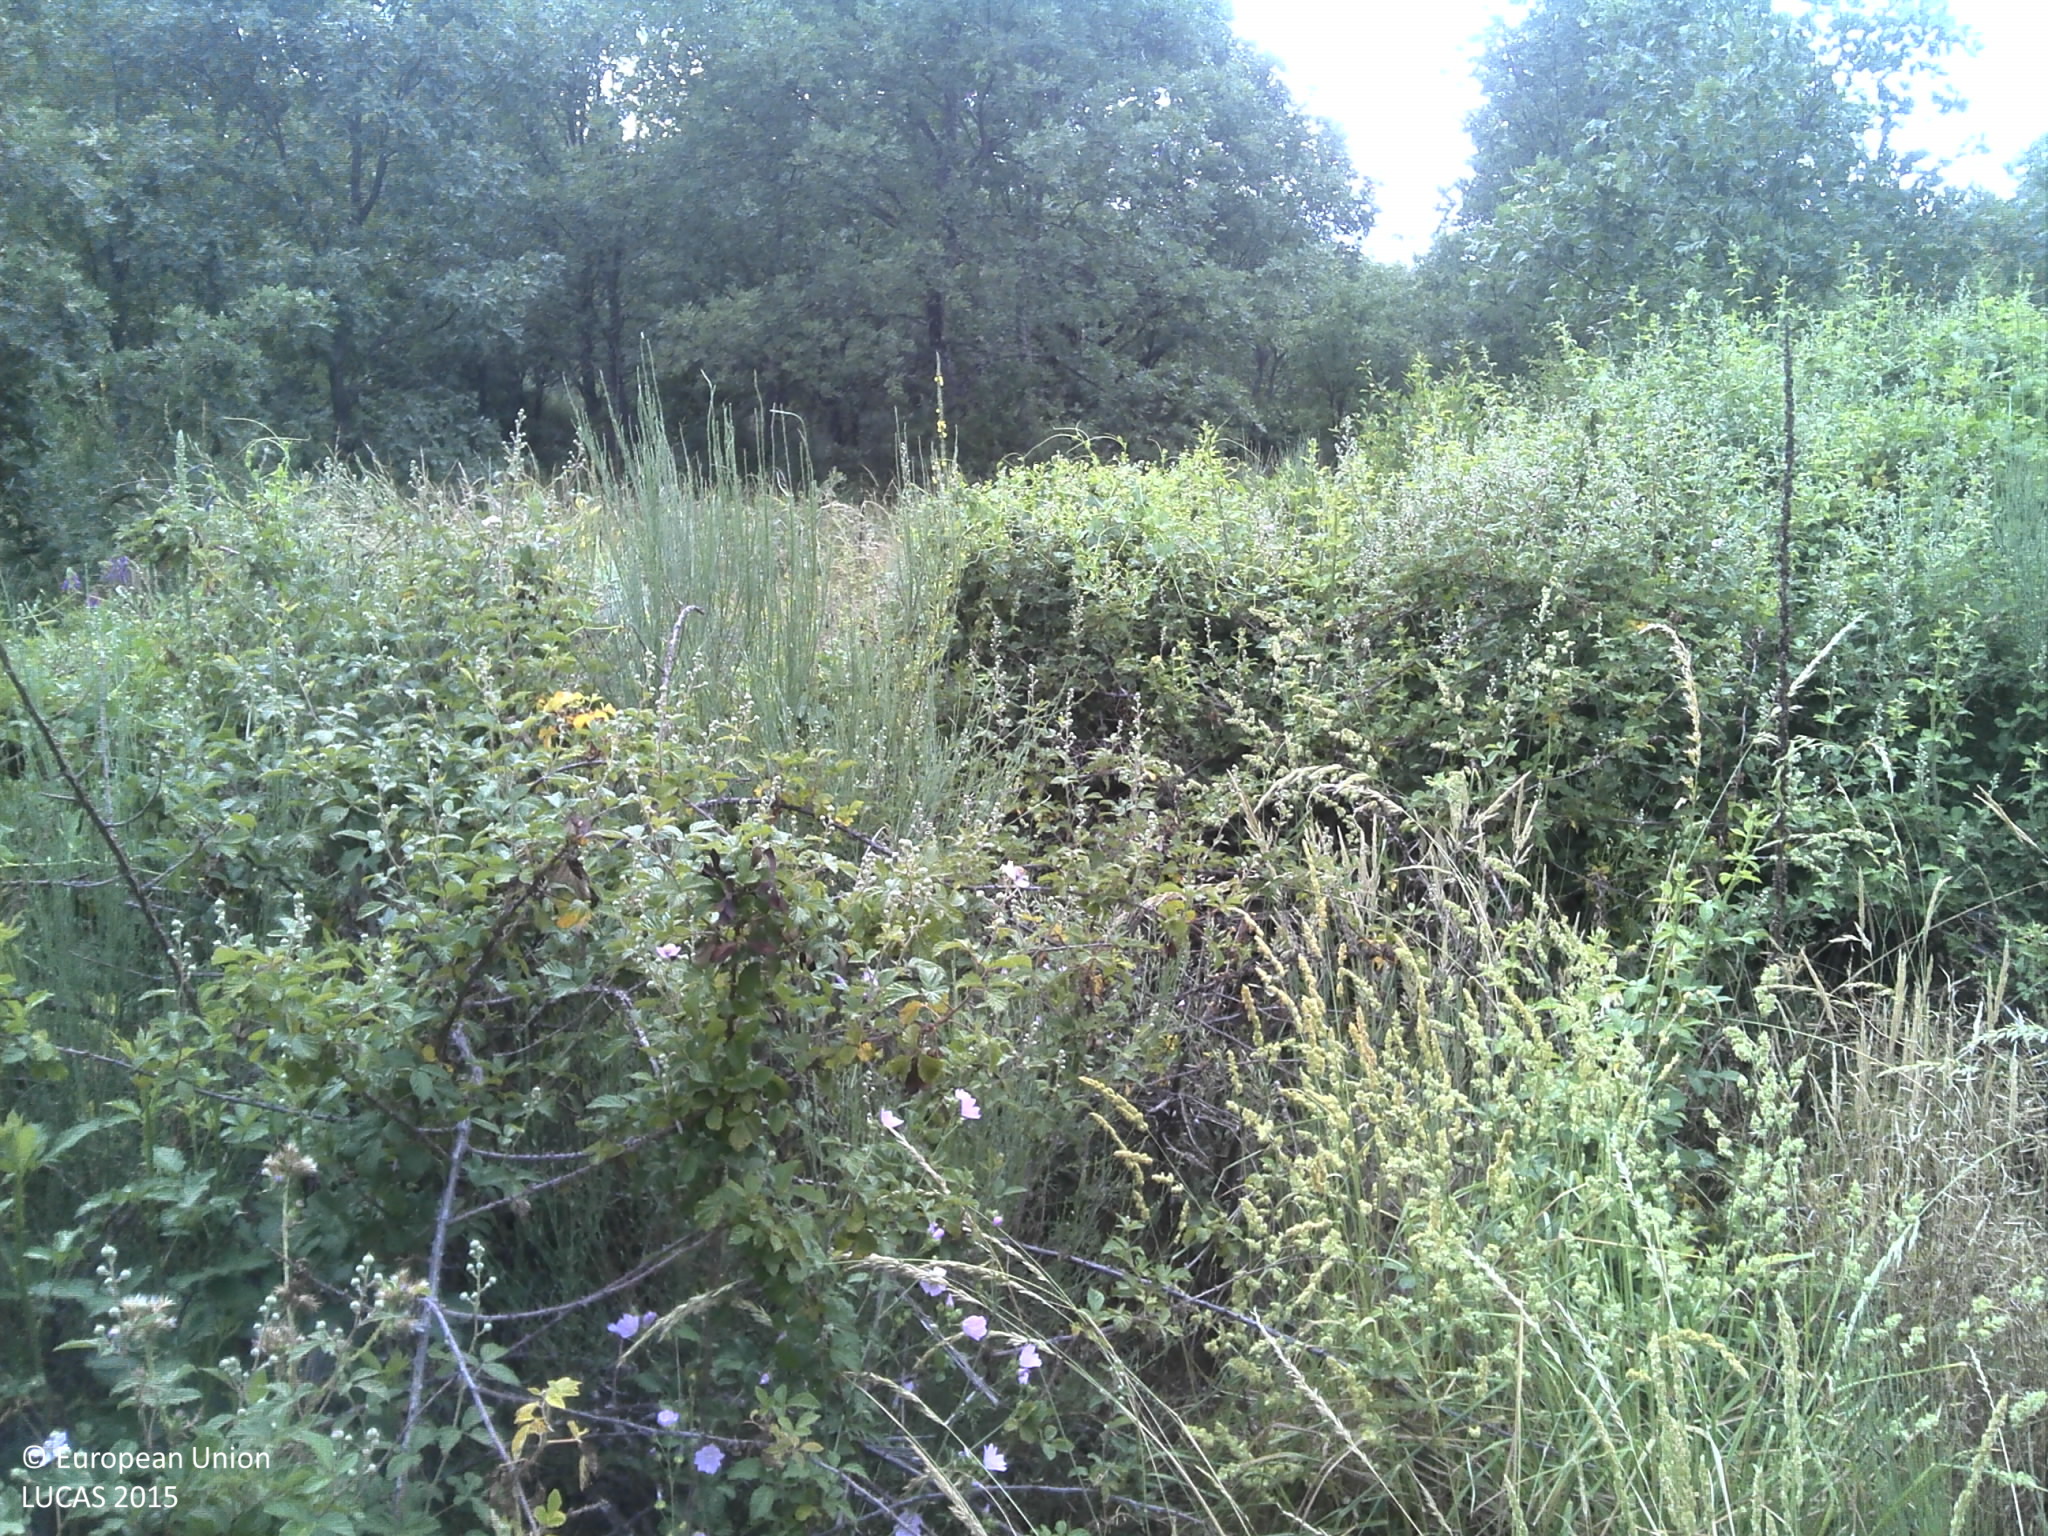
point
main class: Woodland
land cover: Broadleaved woodland
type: acidophilous oak and oak-birch forest
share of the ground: 25 - 50 %
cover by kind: broadleaved forest trees 50 %, shrubs 30 %, unconsolidated bare surface 15 %
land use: Forestry
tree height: > 5 m
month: June
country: PT
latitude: 40.2847
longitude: -7.4073
